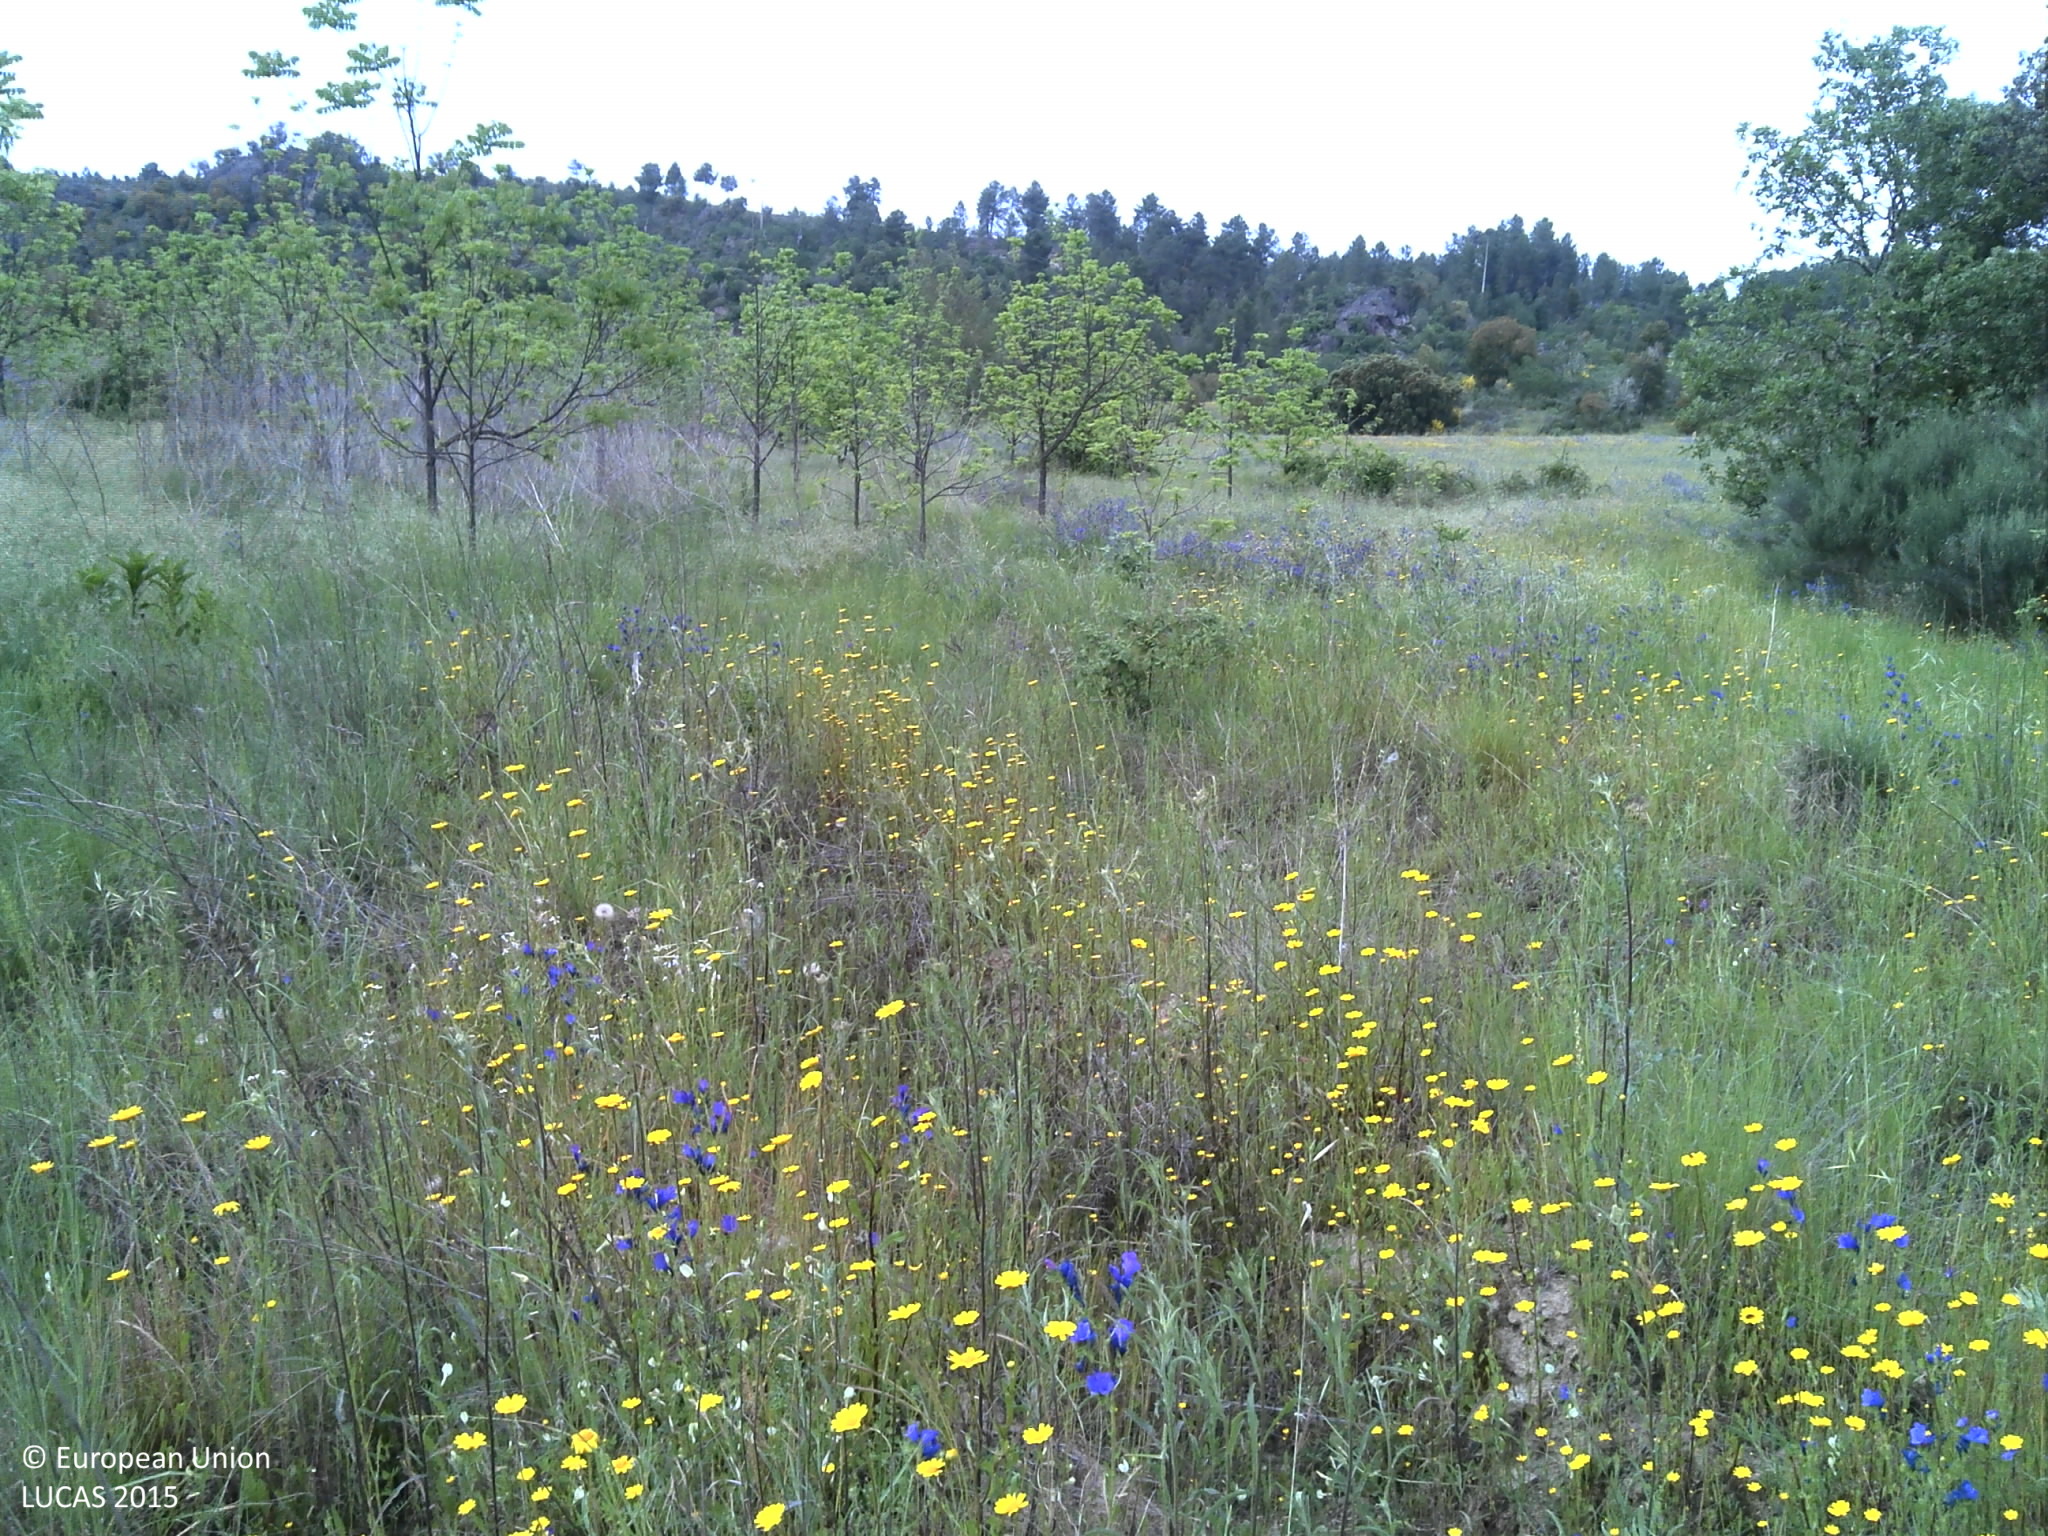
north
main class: Woodland
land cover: Broadleaved woodland
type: exotic forest
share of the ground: 10 - 25 %
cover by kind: herbaceous plants 70 %, broadleaved forest trees 20 %, unconsolidated bare surface 10 %
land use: Forestry
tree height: < 5 m
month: May
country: PT
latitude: 41.6380
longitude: -7.1556
